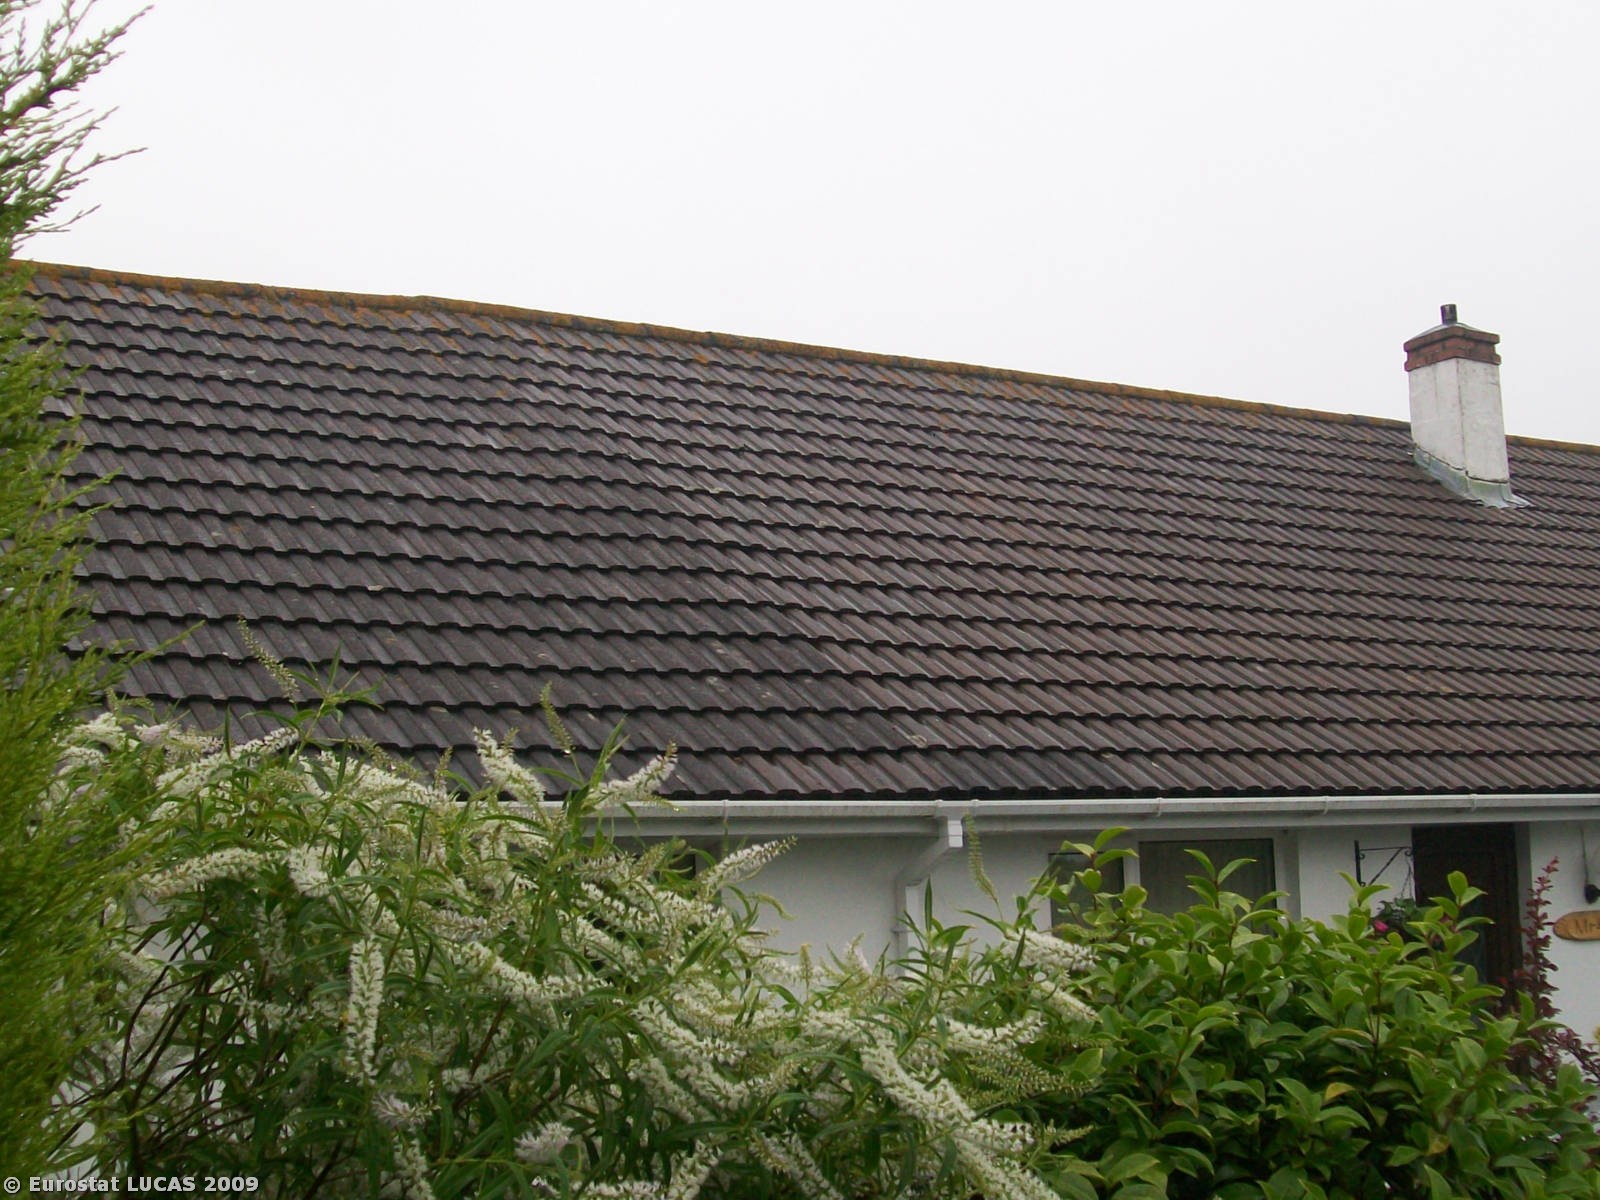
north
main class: Grassland
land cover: Grassland without tree/shrub cover
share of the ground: > 75 %
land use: Residential
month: July
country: GB
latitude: 50.2381
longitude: -5.1924
